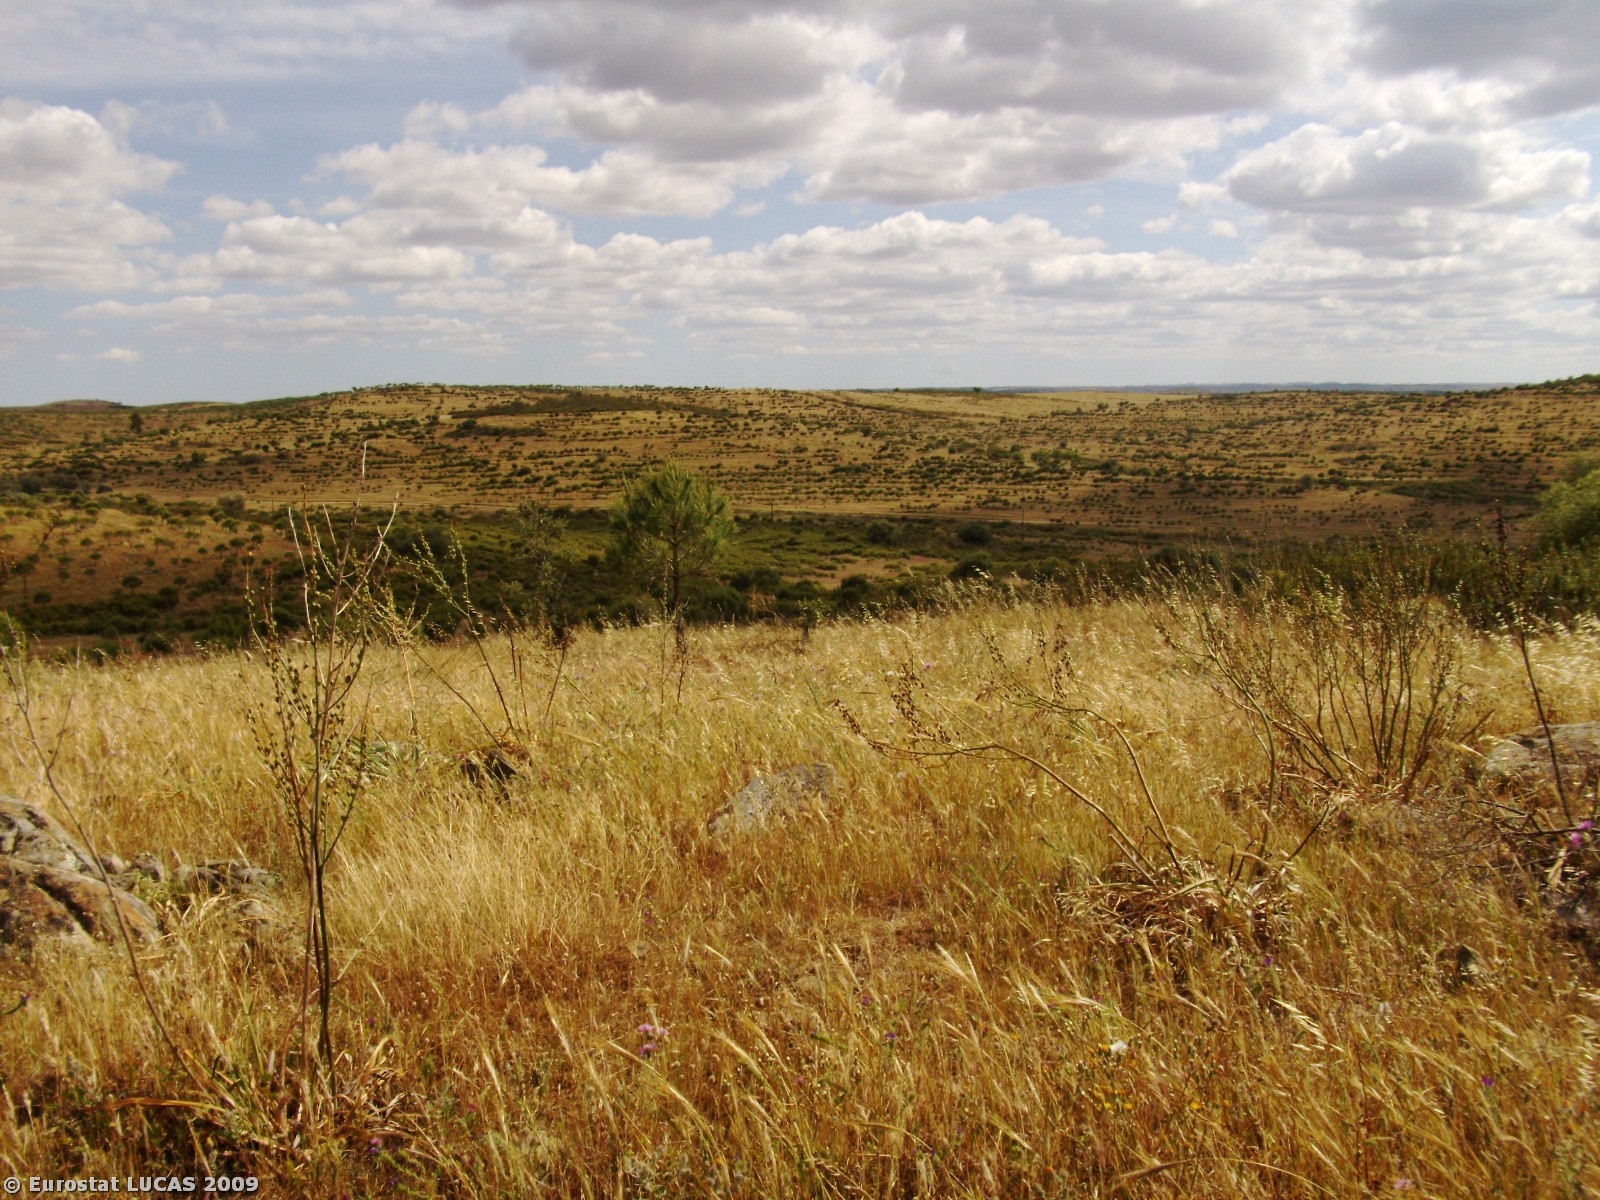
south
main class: Woodland
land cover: Coniferous woodland
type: coniferous forest of the mediterranean region
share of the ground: 25 - 50 %
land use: Forestry
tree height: > 5 m
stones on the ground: < 10 %
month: April
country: PT
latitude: 37.5517
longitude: -7.7069
